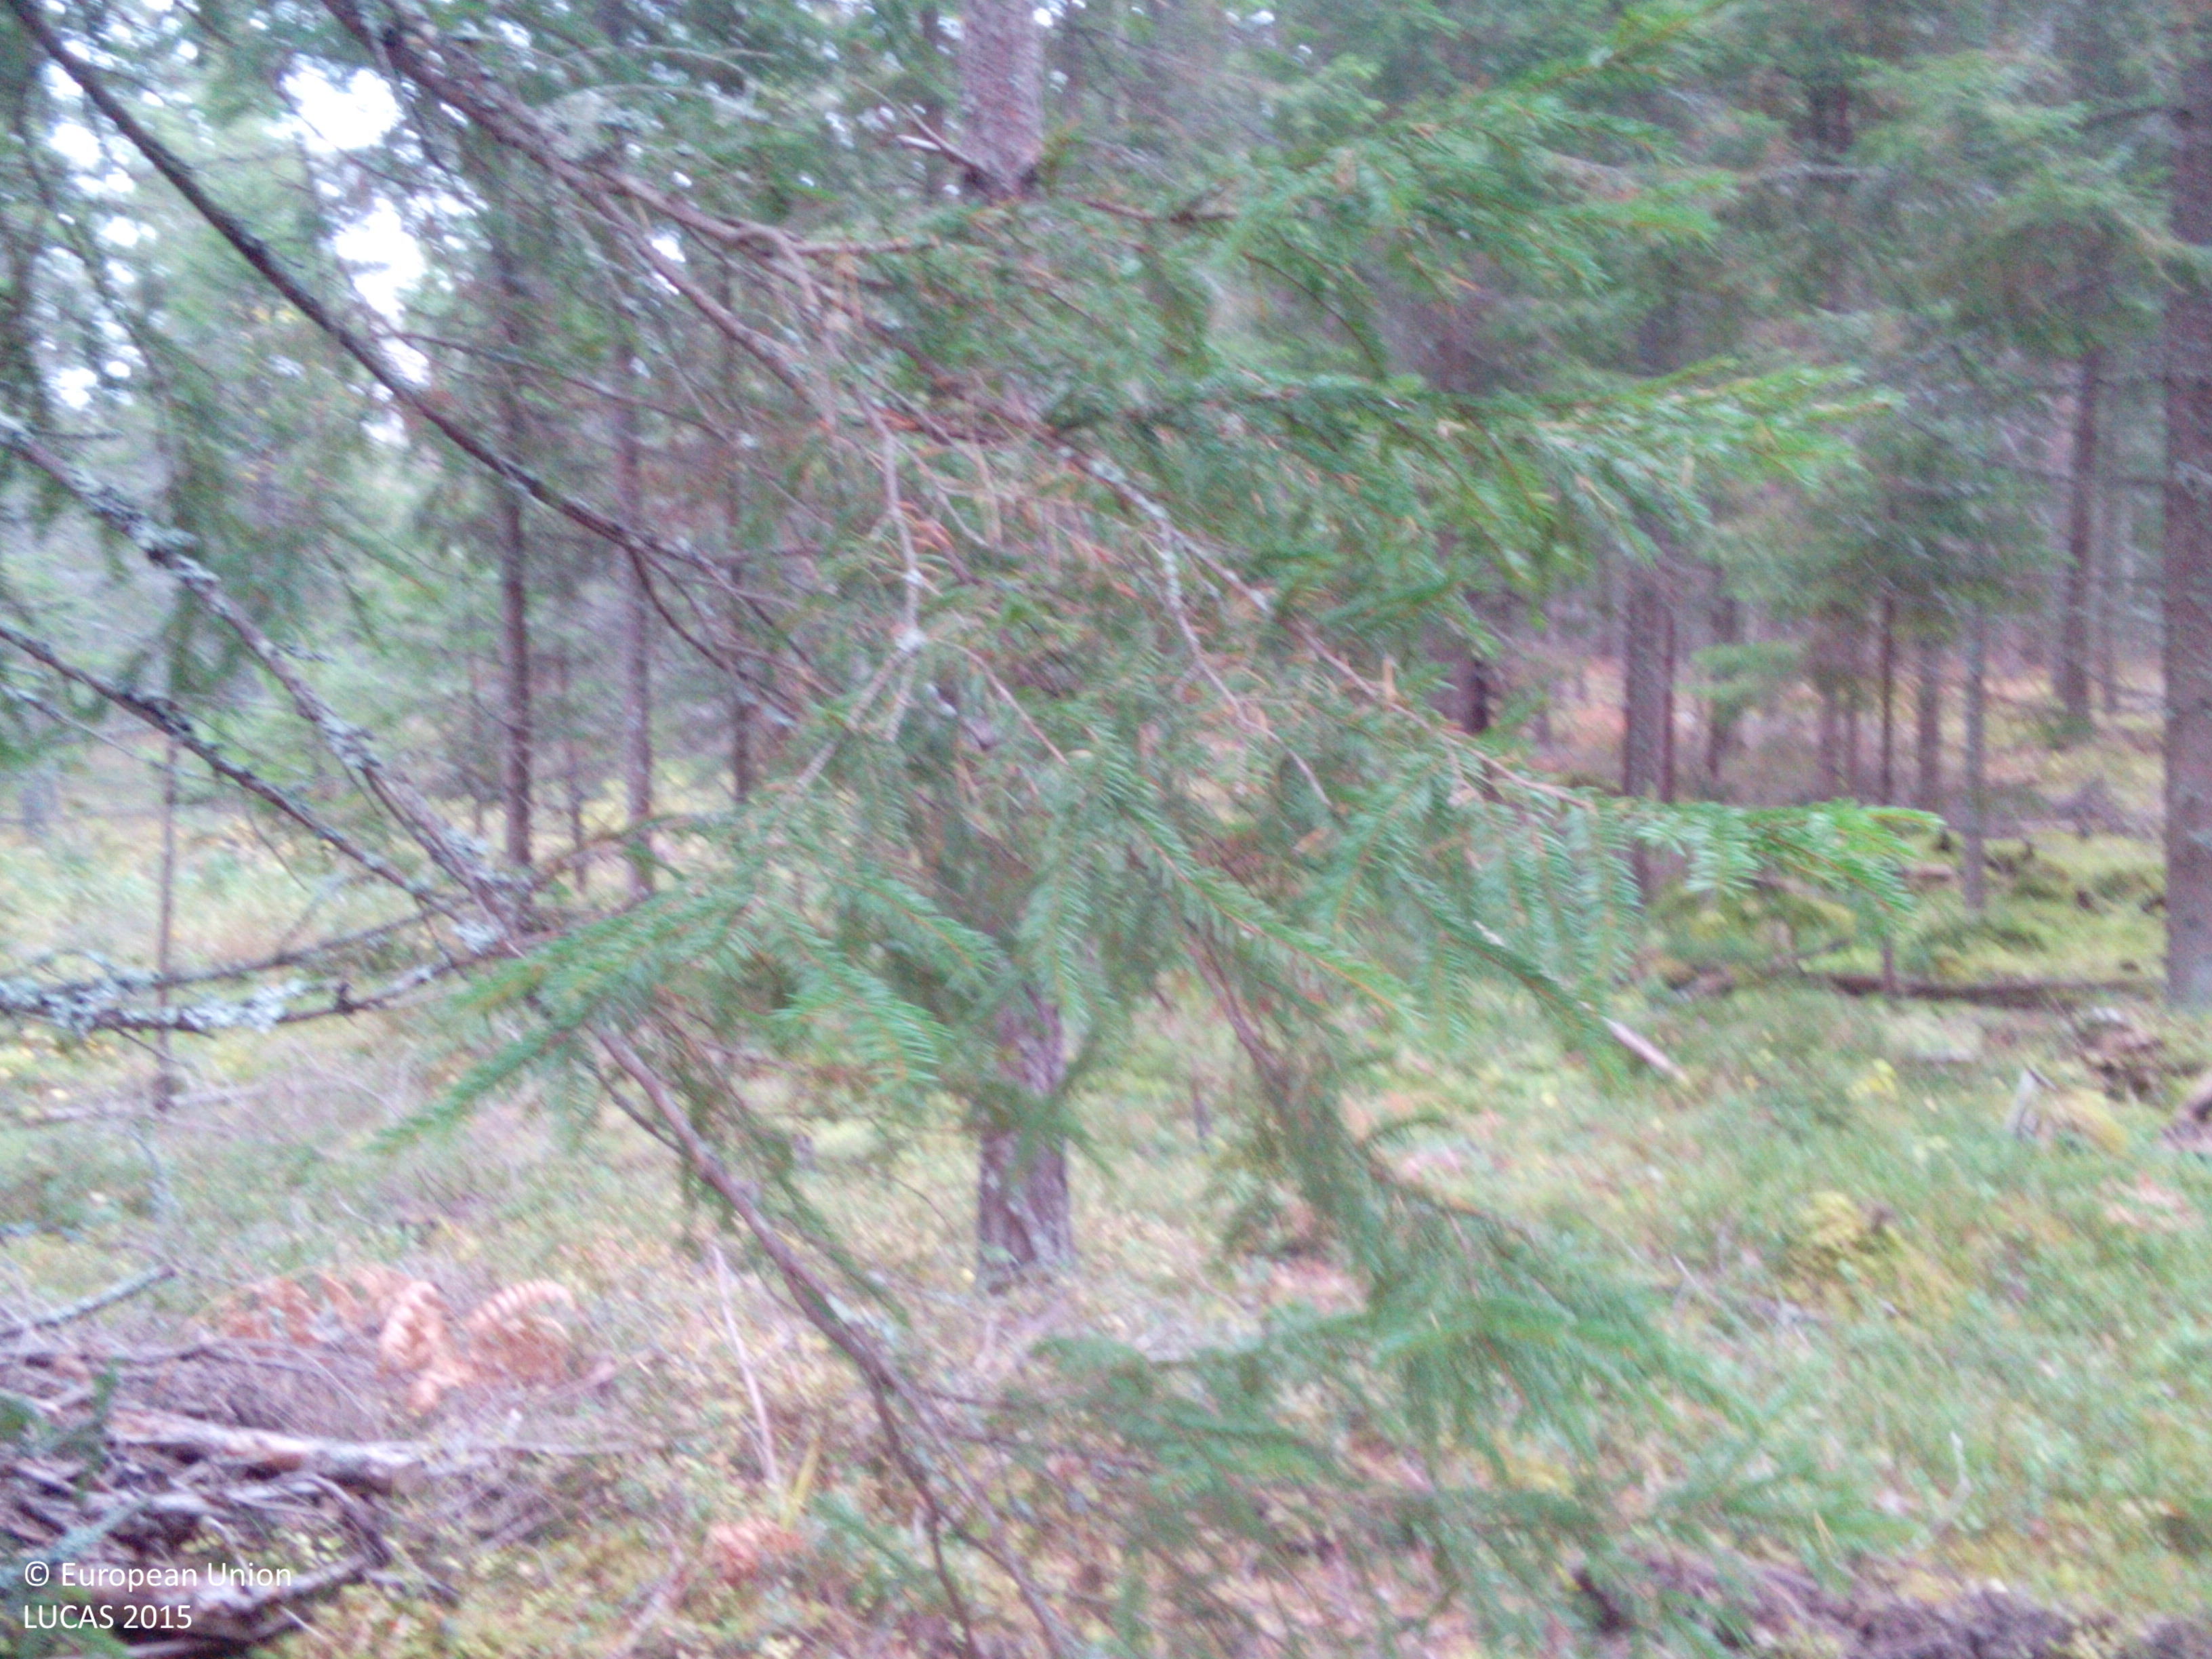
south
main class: Woodland
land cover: Other coniferous woodland
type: boreal forest
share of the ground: > 75 %
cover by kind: coniferous forest trees 75 %, herbaceous plants 10 %, lichens and mosses 10 %, broadleaved forest trees 5 %
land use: Forestry
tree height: > 5 m
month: October
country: SE
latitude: 59.1710
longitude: 16.3438
